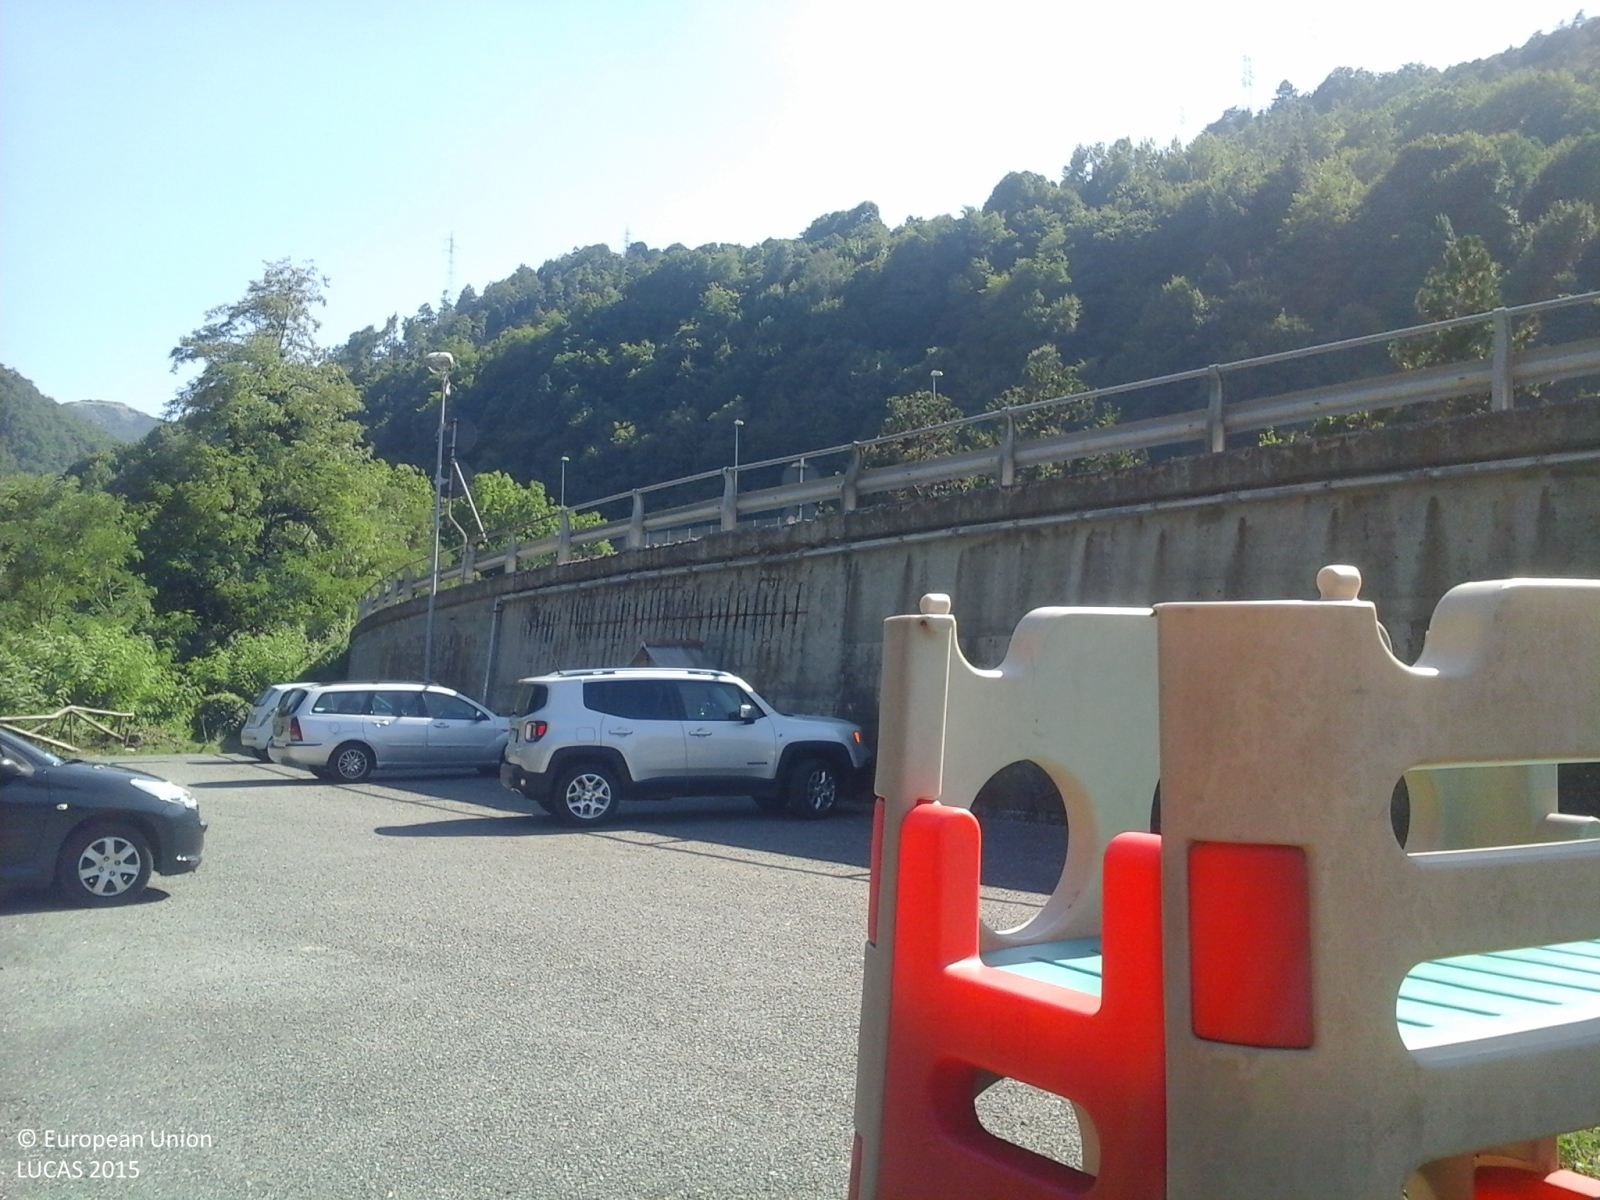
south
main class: Grassland
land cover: Grassland with sparse tree/shrub cover
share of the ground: > 75 %
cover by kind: herbaceous plants 85 %, shrubs 10 %, broadleaved forest trees 5 %
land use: Semi-natural and natural areas not in use
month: August
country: IT
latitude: 44.5048
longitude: 8.7073
